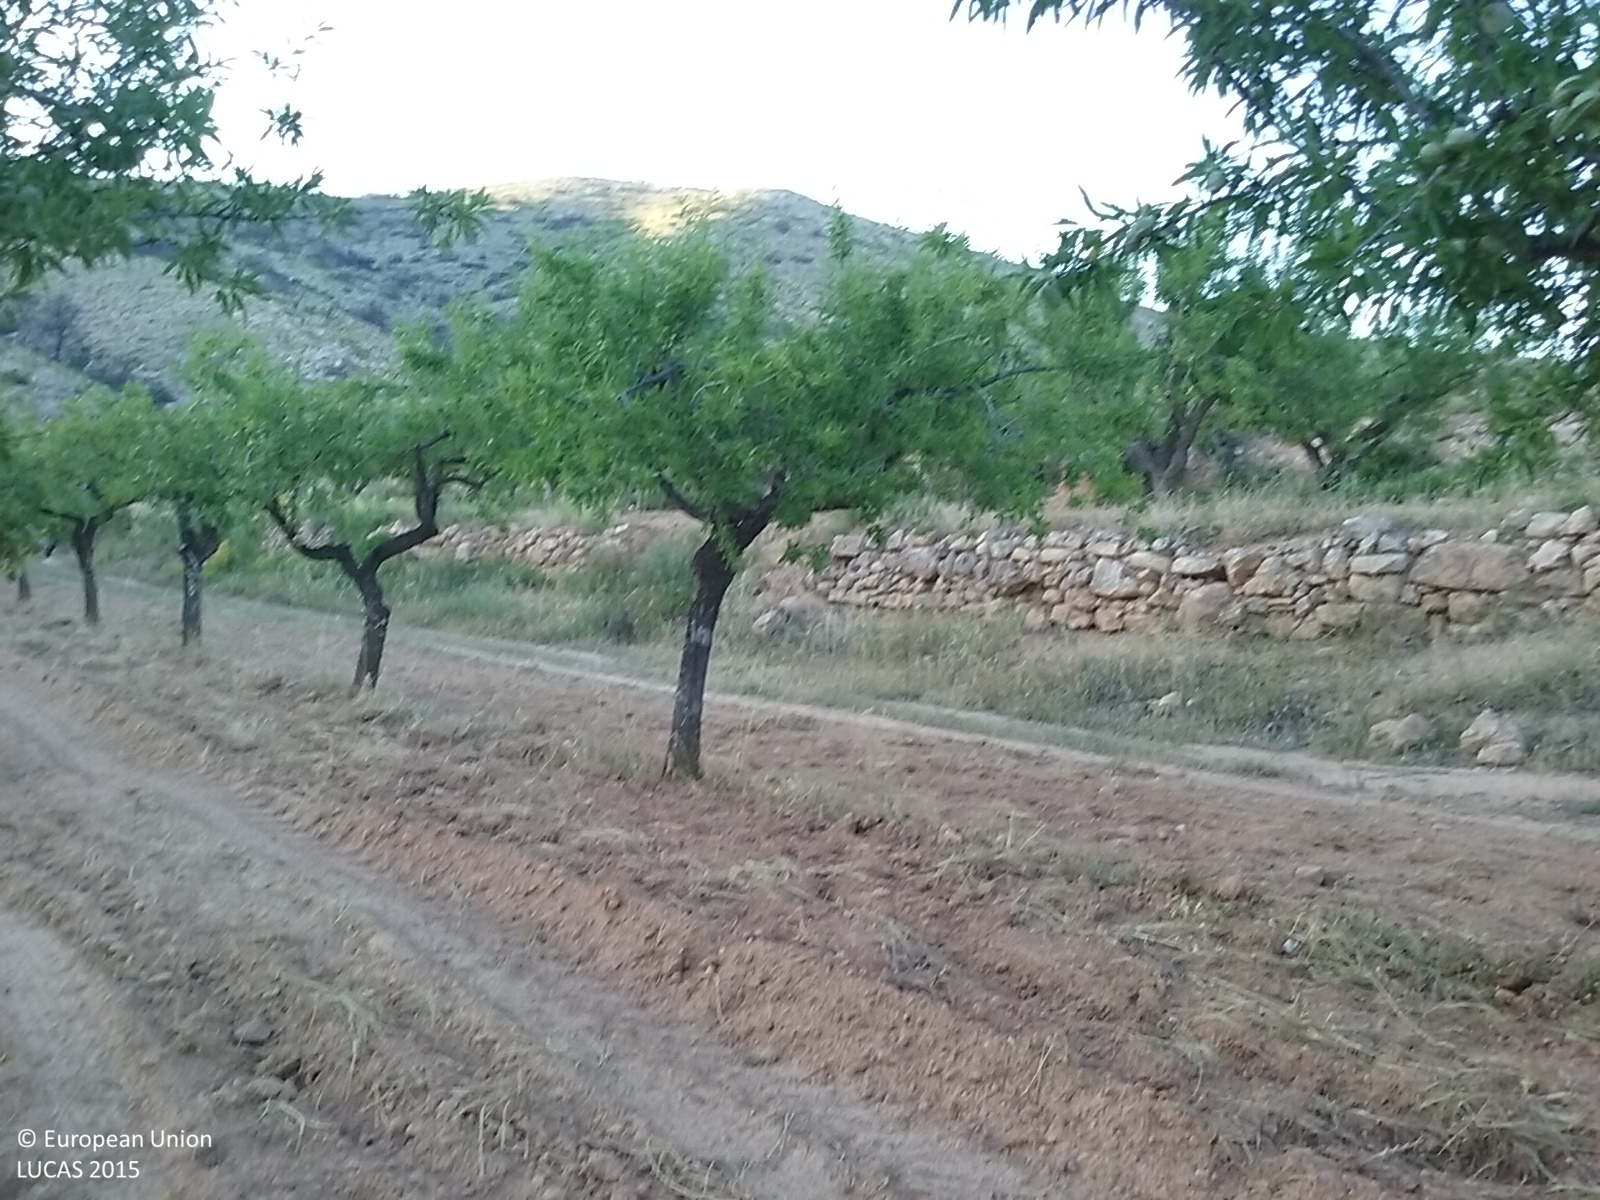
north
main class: Cropland
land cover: Nuts trees
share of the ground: 50 - 75 %
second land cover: Other bare soil
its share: > 75 %
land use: Agriculture (excluding fallow land and kitchen gardens)
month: June
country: ES
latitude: 39.8066
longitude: -0.7134
